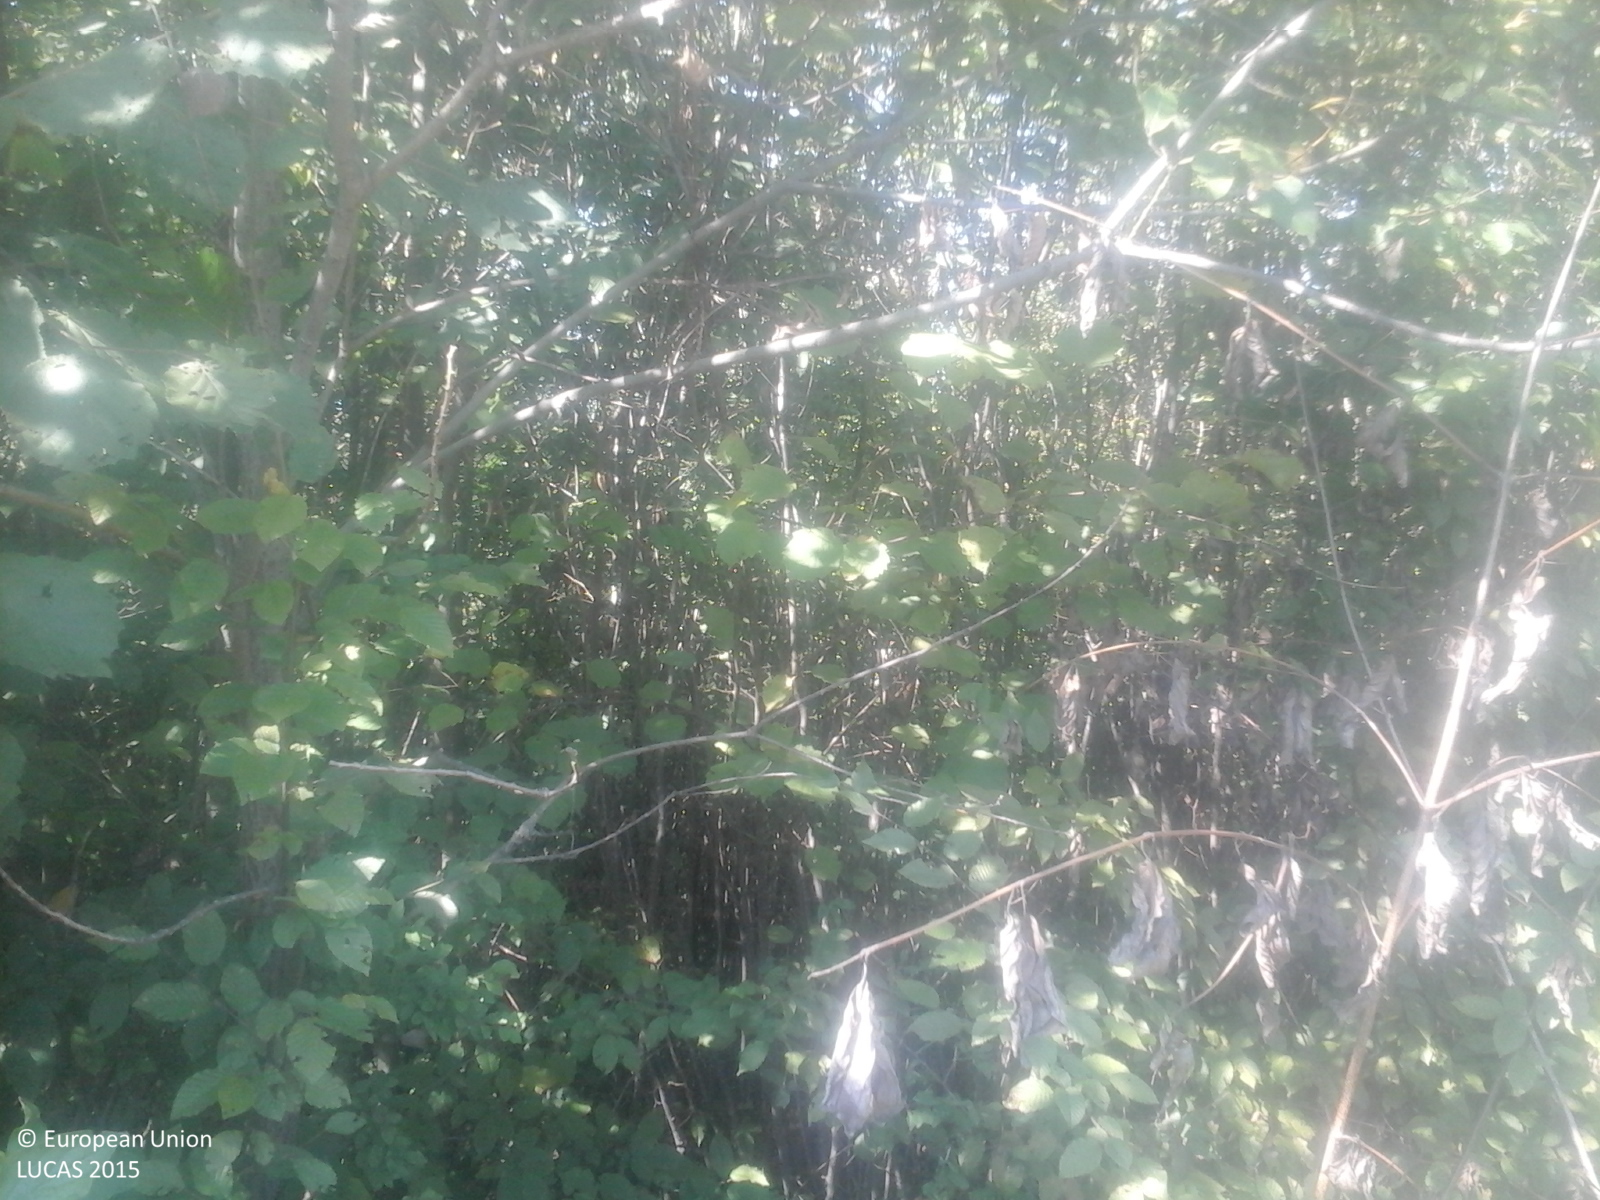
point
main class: Woodland
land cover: Broadleaved woodland
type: acidophilous oak and oak-birch forest
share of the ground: > 75 %
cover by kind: broadleaved forest trees 100 %
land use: Forestry
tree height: > 5 m
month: September
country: RO
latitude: 46.6586
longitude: 22.2943
